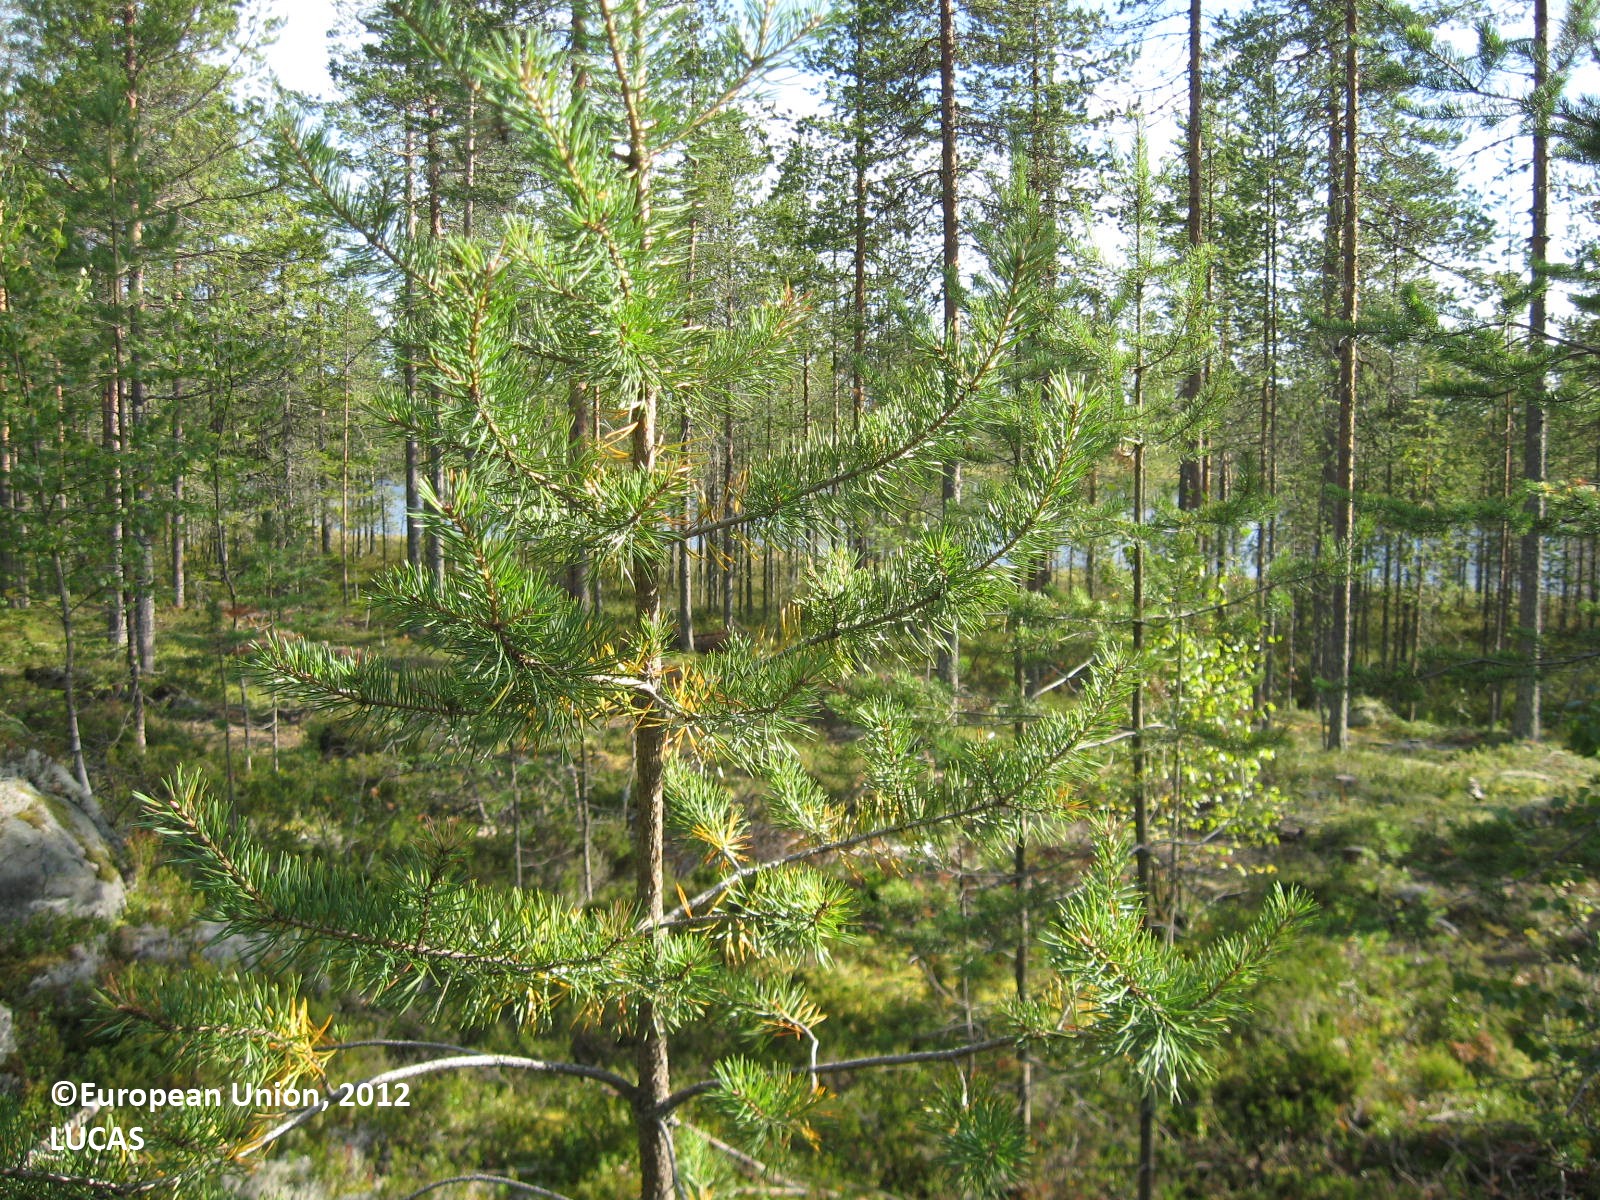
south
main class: Woodland
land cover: Pine dominated mixed woodland
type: boreal forest
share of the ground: > 75 %
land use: Forestry
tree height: > 5 m
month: August
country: FI
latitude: 63.6382
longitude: 29.6287
